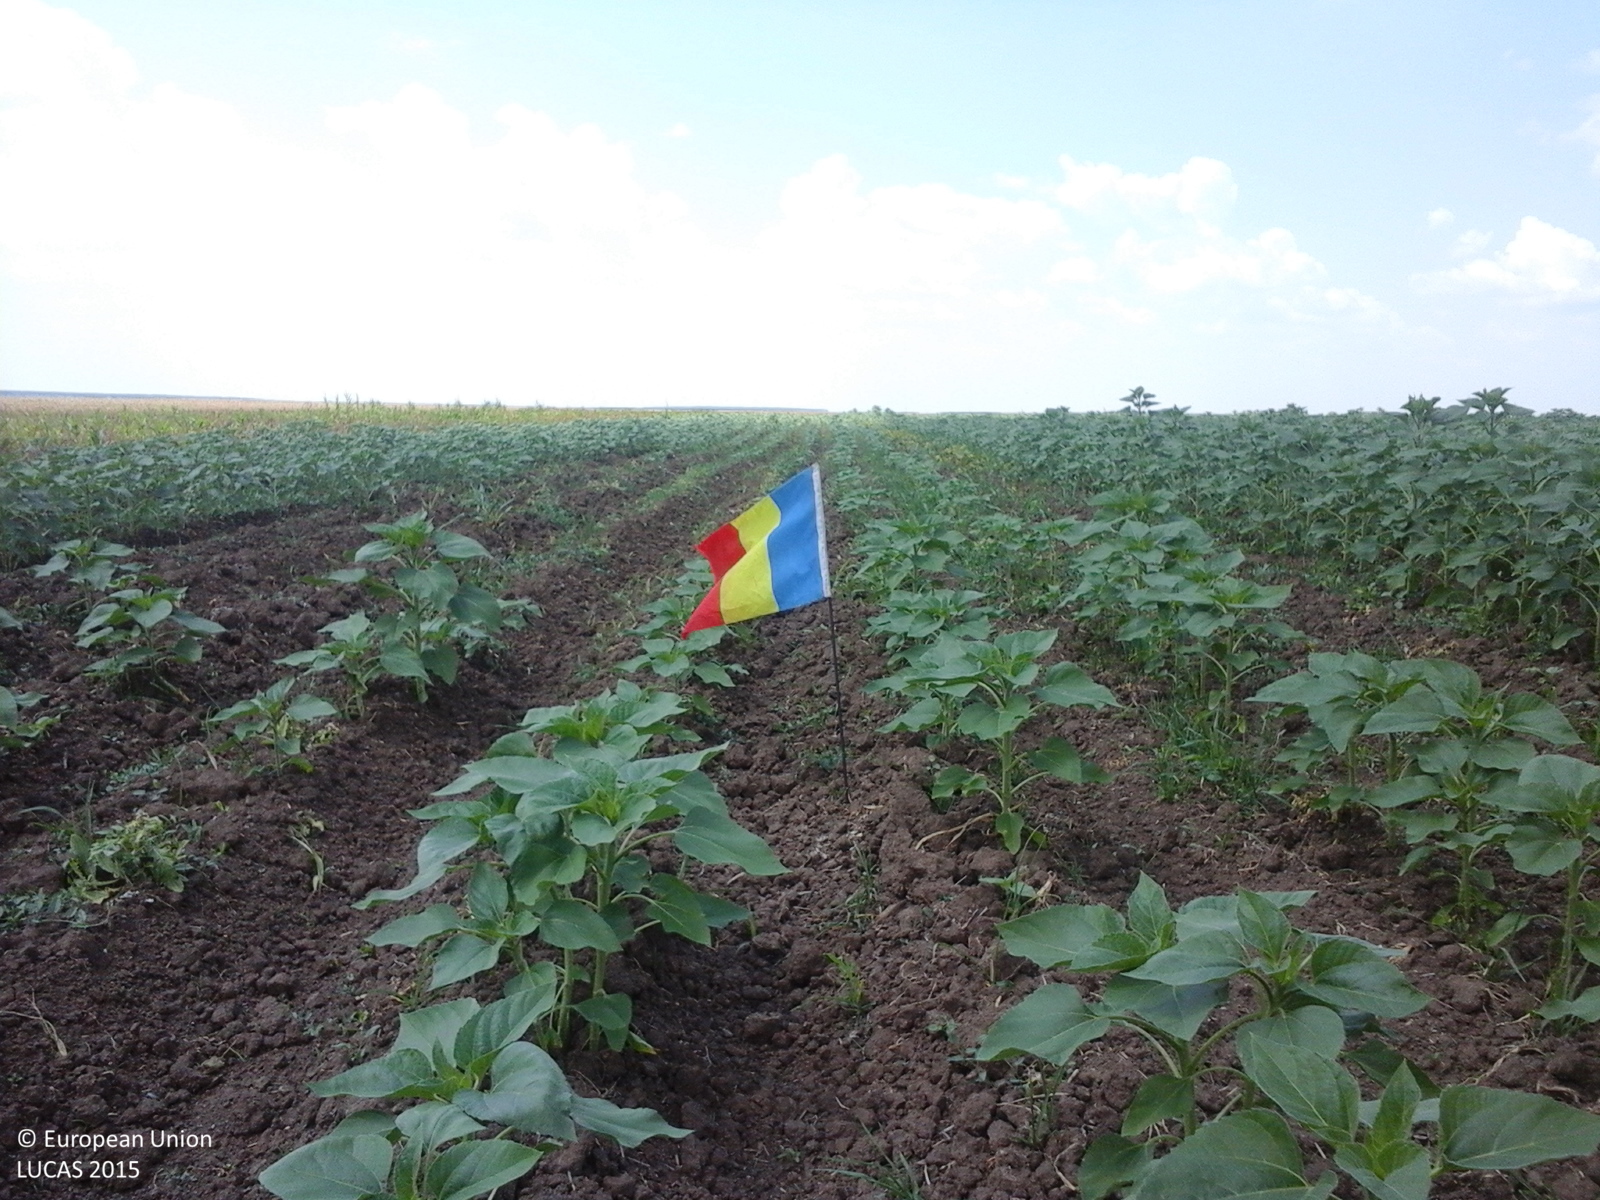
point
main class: Cropland
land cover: Sunflower
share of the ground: 50 - 75 %
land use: Agriculture (excluding fallow land and kitchen gardens)
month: July
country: RO
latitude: 44.1080
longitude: 25.2880
